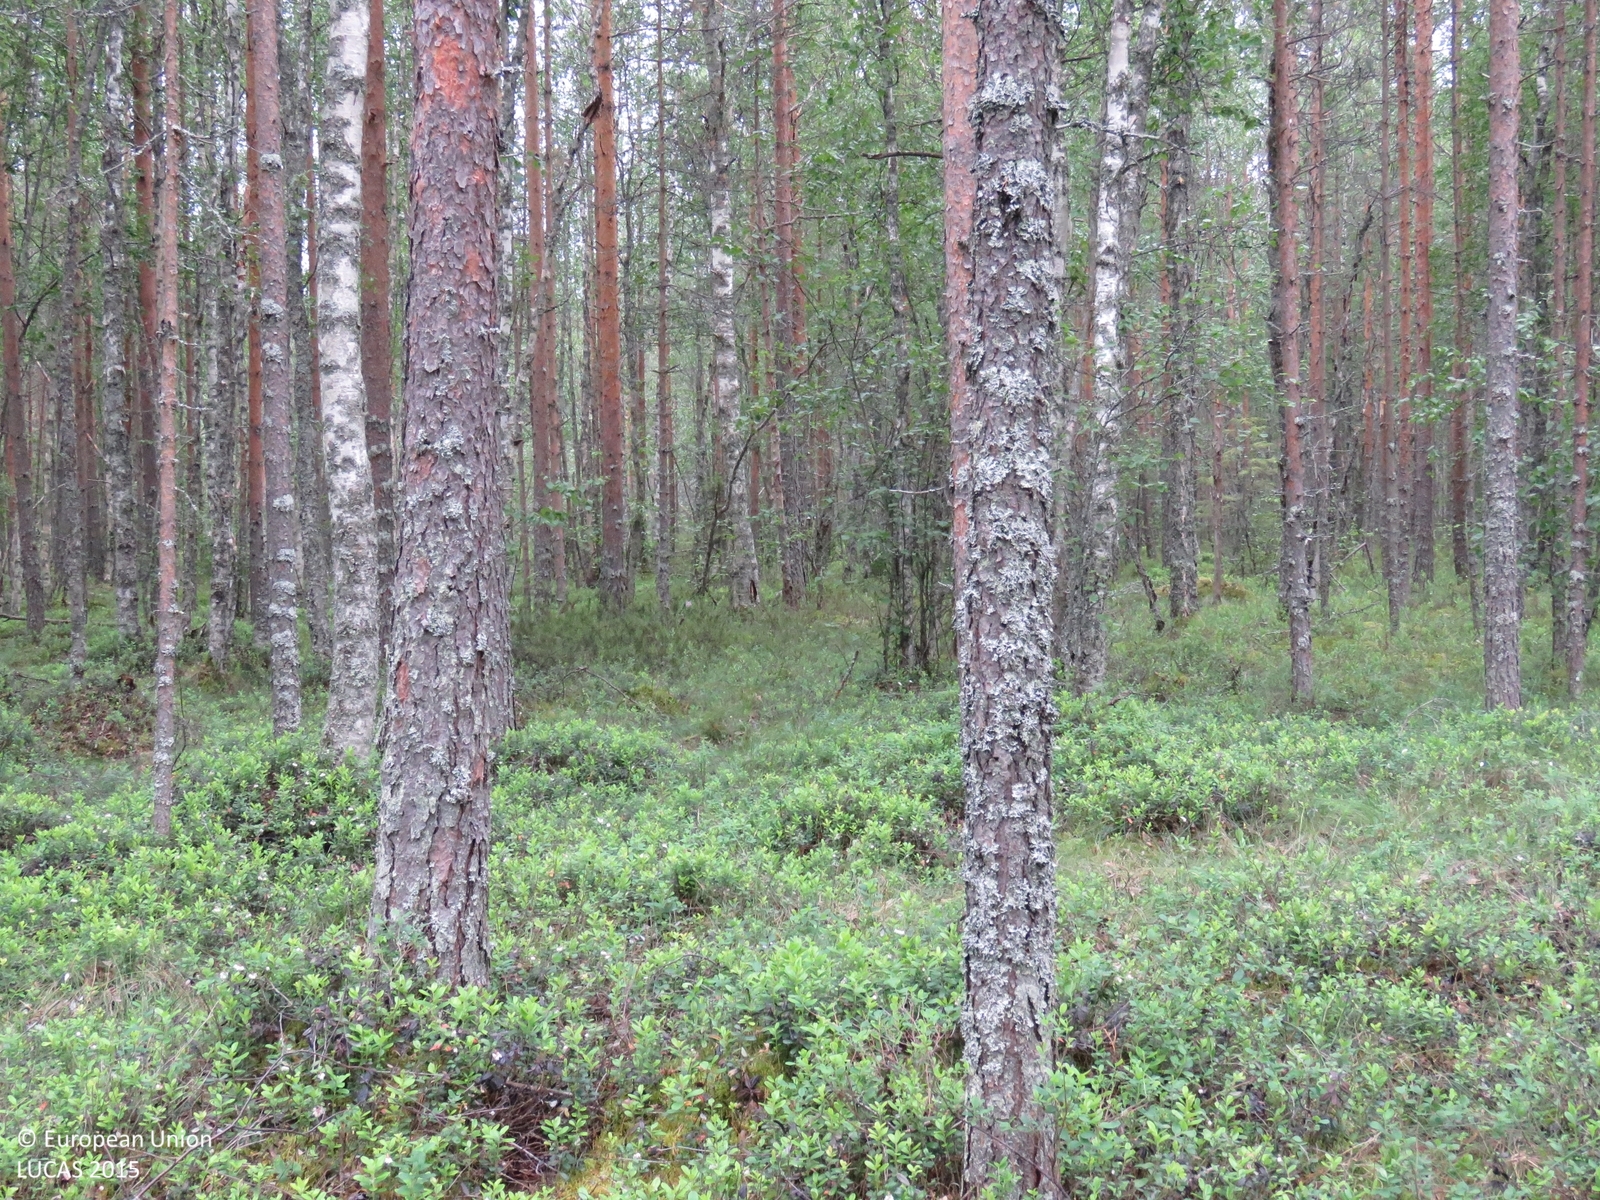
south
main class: Woodland
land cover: Pine dominated mixed woodland
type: boreal forest
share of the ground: > 75 %
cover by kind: broadleaved forest trees 40 %, coniferous forest trees 35 %, shrubs 20 %, herbaceous plants 5 %
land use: Forestry
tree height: > 5 m
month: July
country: FI
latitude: 64.3723
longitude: 26.3796
